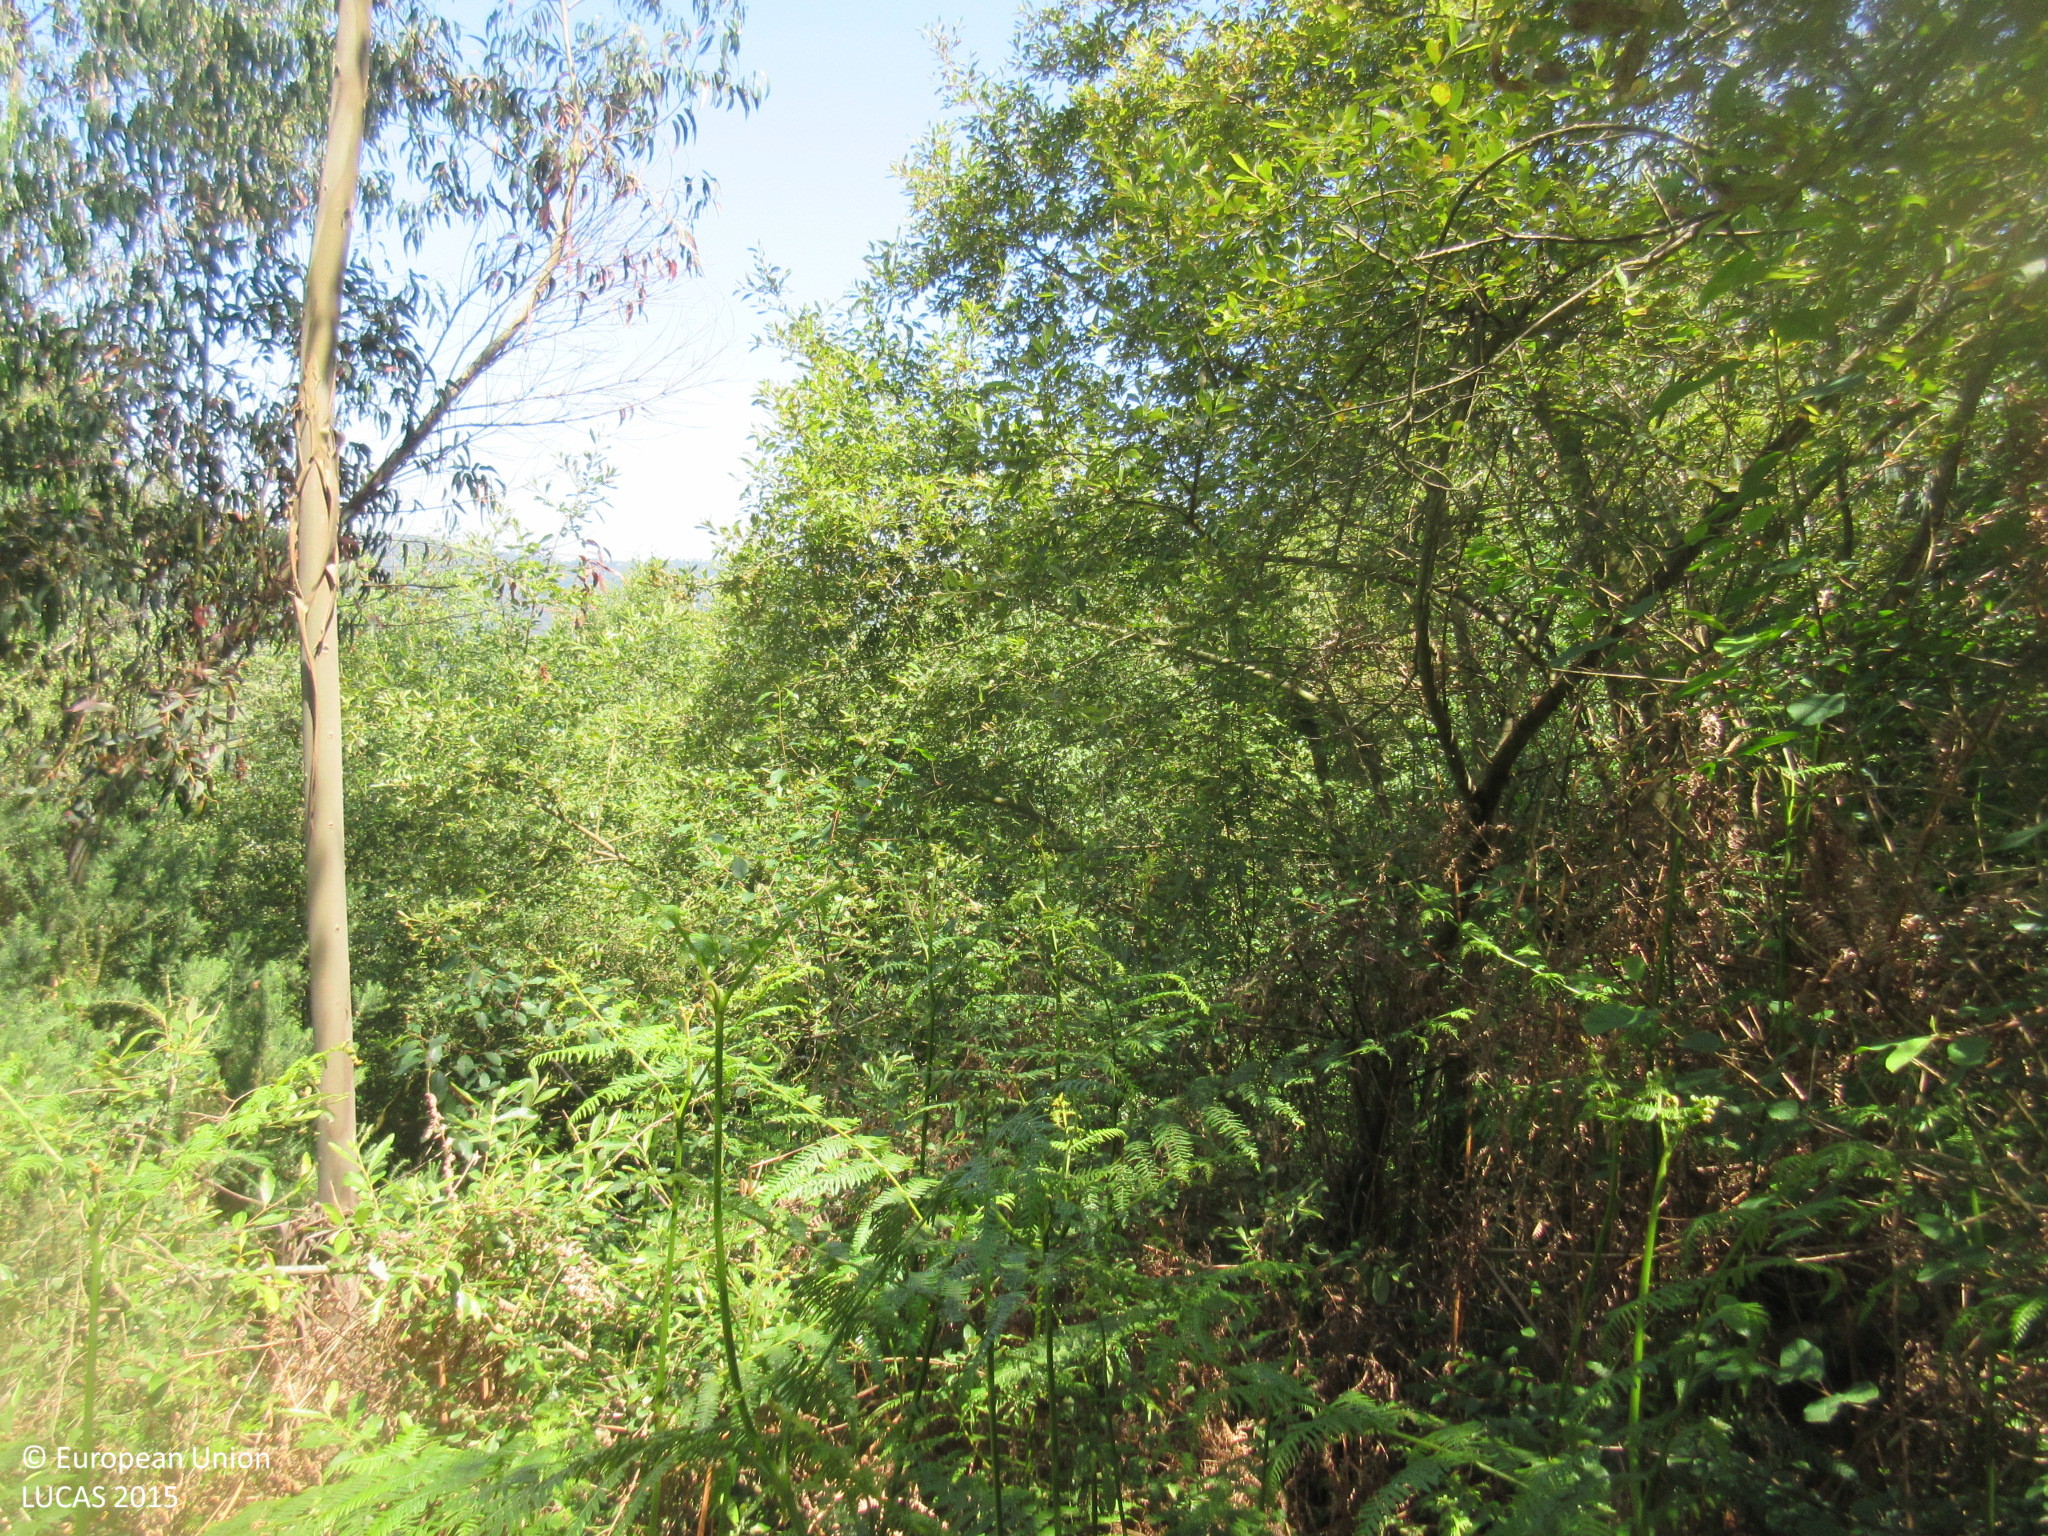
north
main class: Woodland
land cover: Broadleaved woodland
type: exotic forest
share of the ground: > 75 %
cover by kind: broadleaved forest trees 80 %, shrubs 20 %
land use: Forestry
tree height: > 5 m
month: June
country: ES
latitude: 43.4451
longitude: -6.0198
